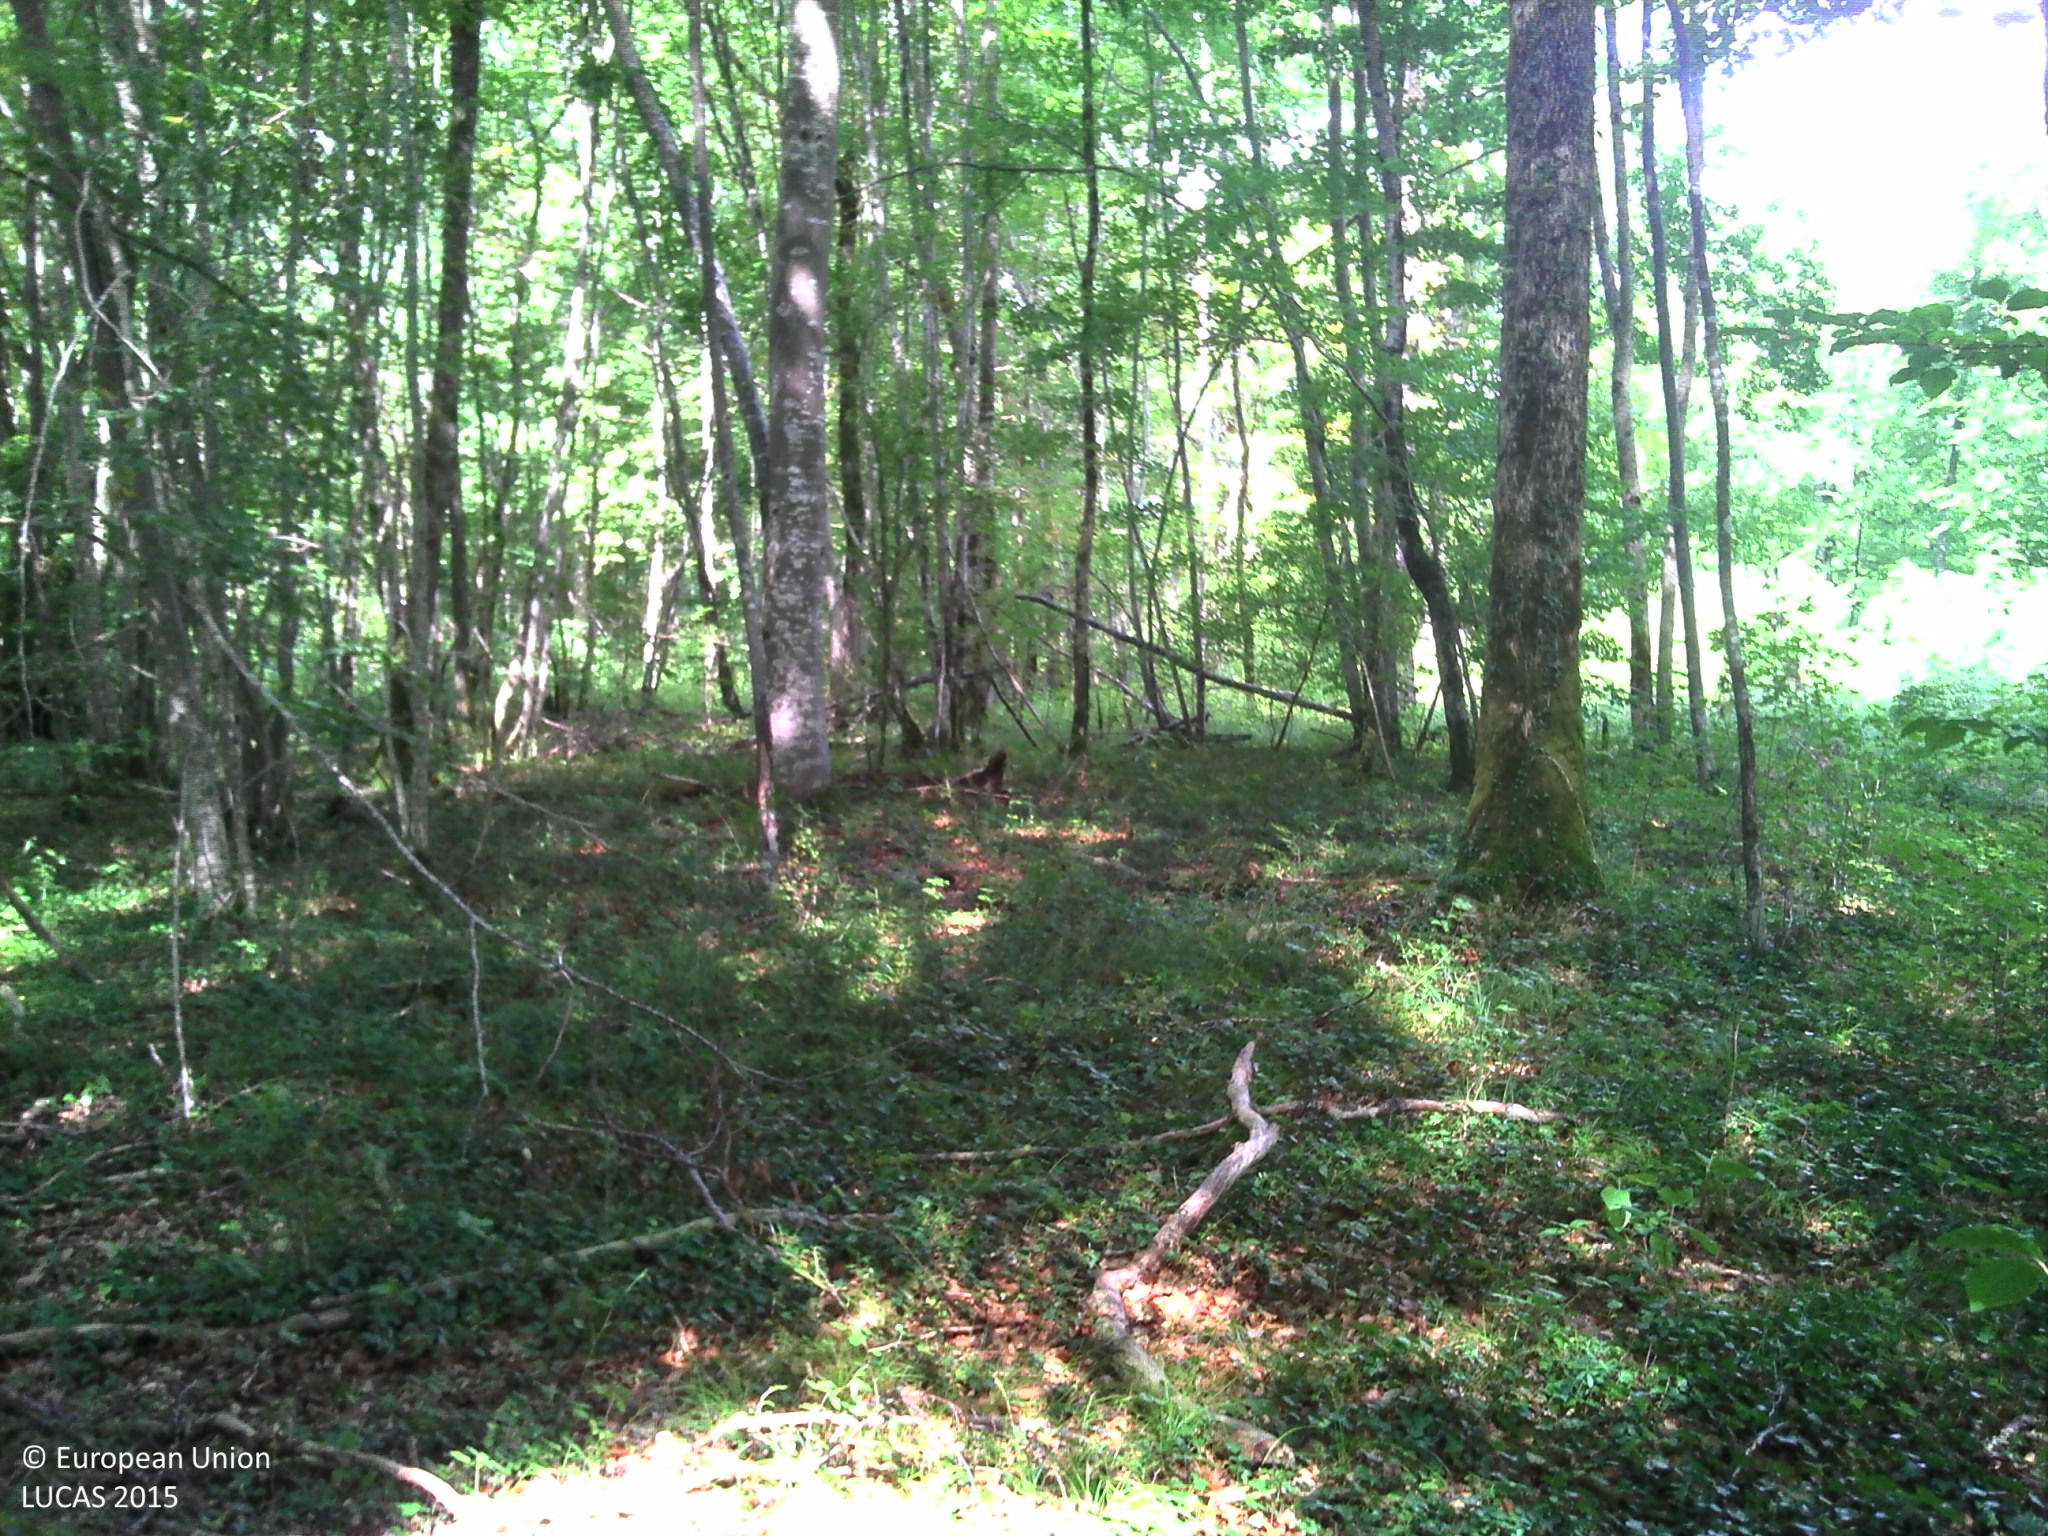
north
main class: Woodland
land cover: Broadleaved woodland
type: mesophytic deciduous forest
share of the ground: > 75 %
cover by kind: broadleaved forest trees 80 %, shrubs 10 %, herbaceous plants 10 %
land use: Forestry
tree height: > 5 m
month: September
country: FR
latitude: 47.4844
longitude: 4.7309
